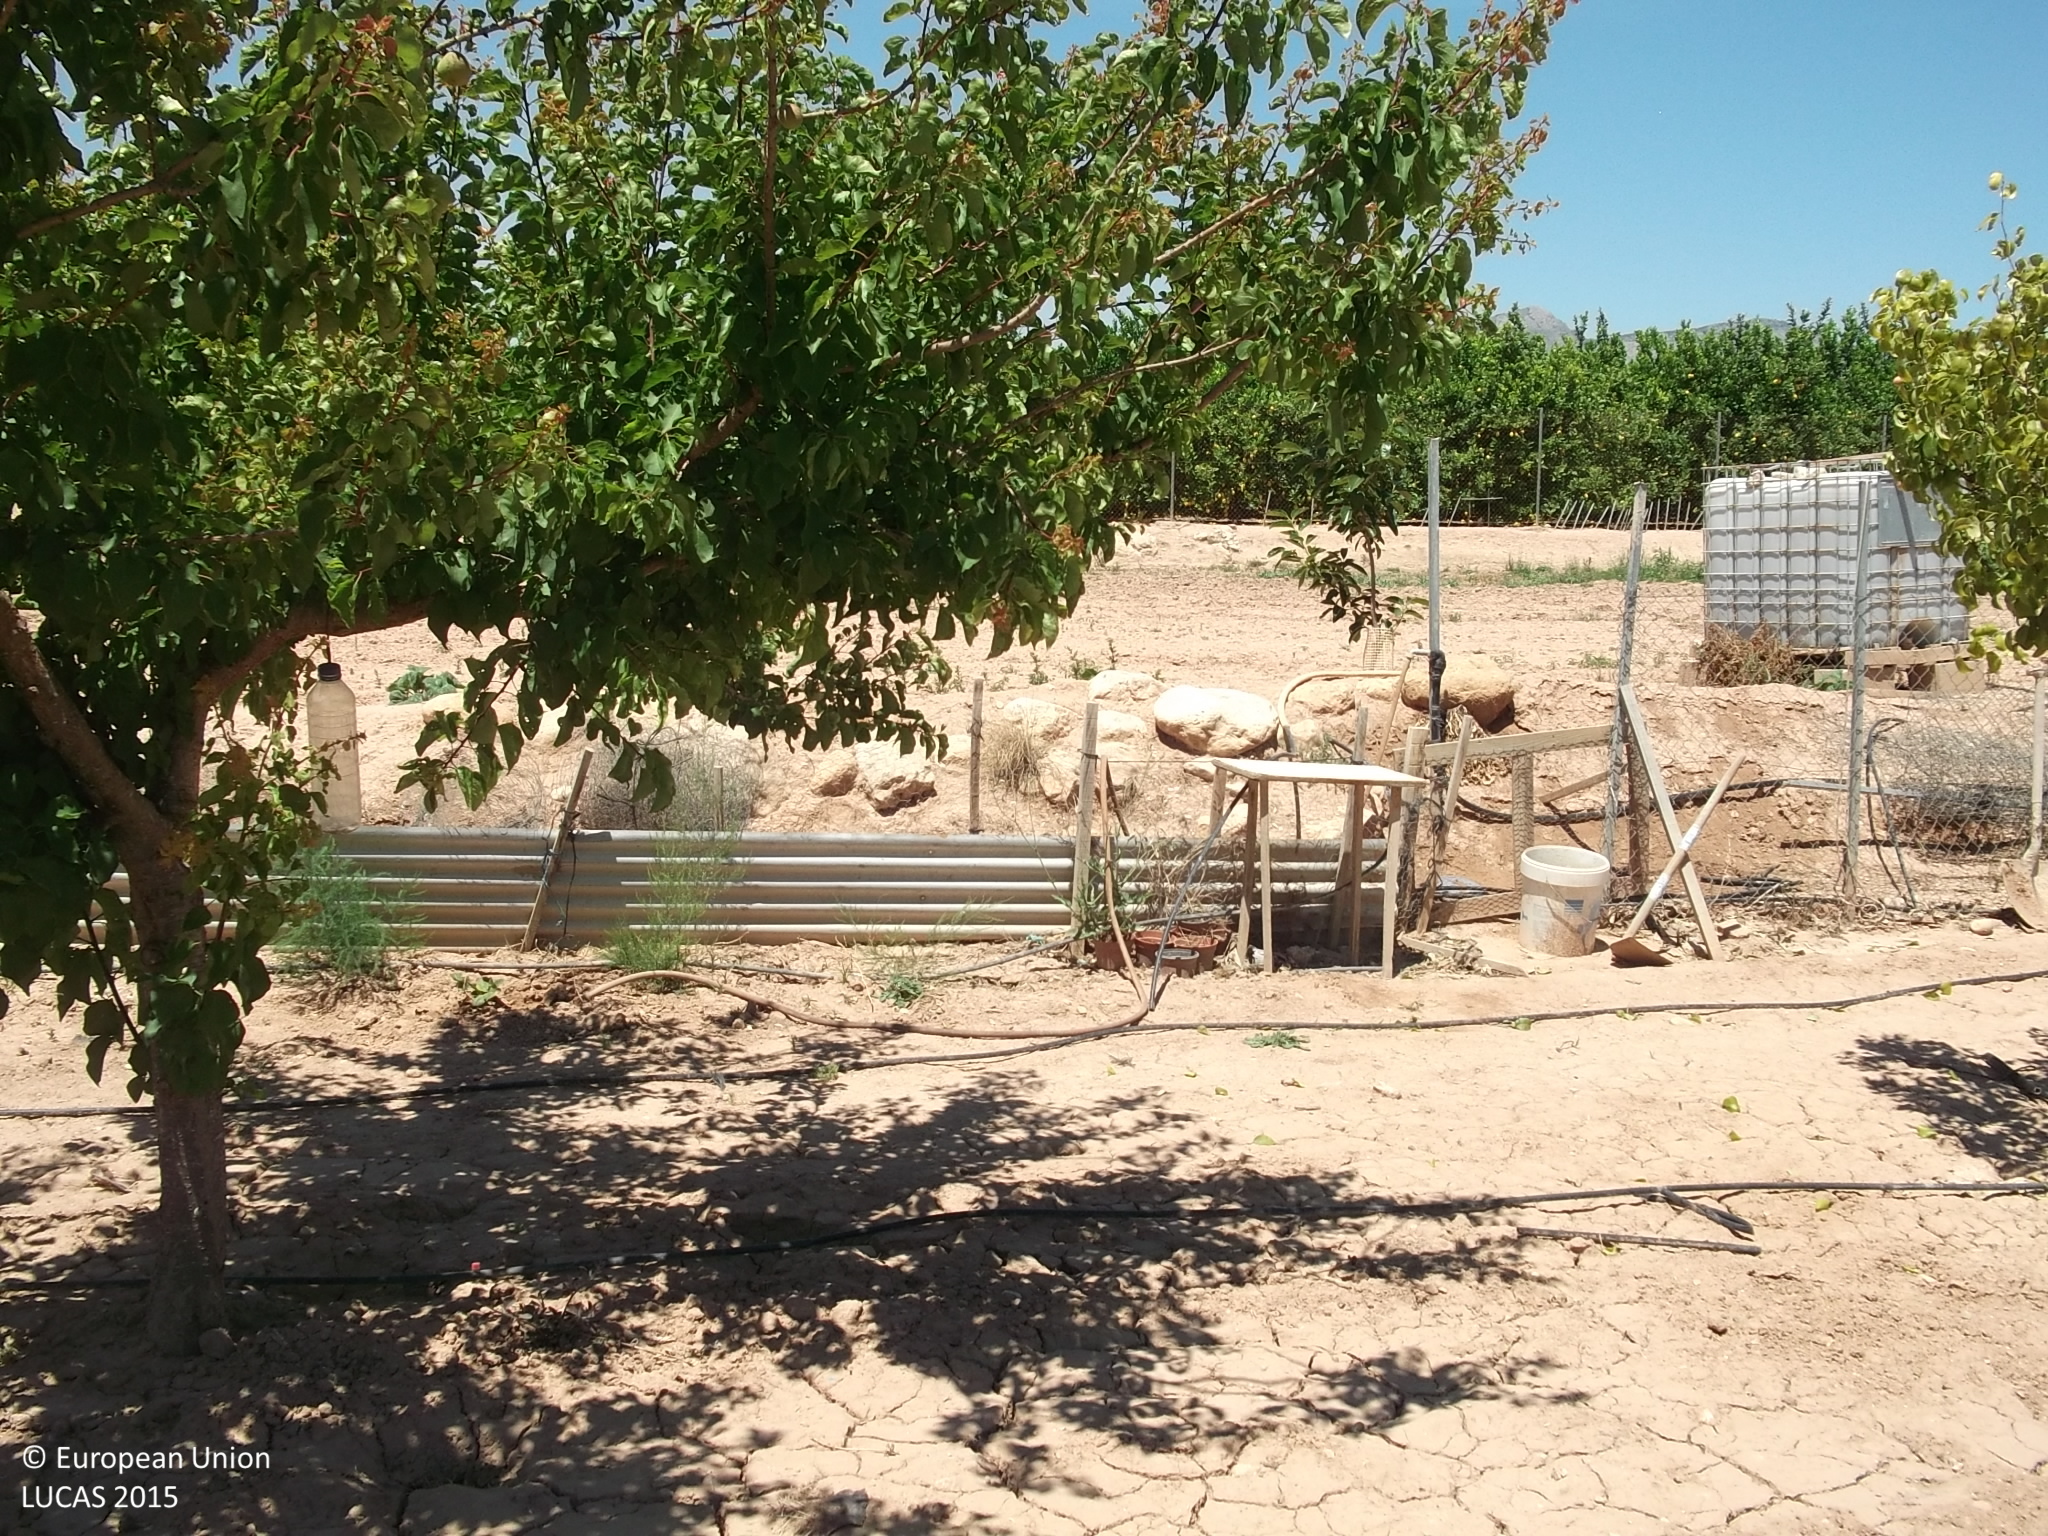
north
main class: Cropland
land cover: Other fruit trees and berries
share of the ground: < 10 %
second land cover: Other bare soil
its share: > 75 %
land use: Agriculture (excluding fallow land and kitchen gardens)
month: May
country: ES
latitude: 38.1807
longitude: -0.8875
